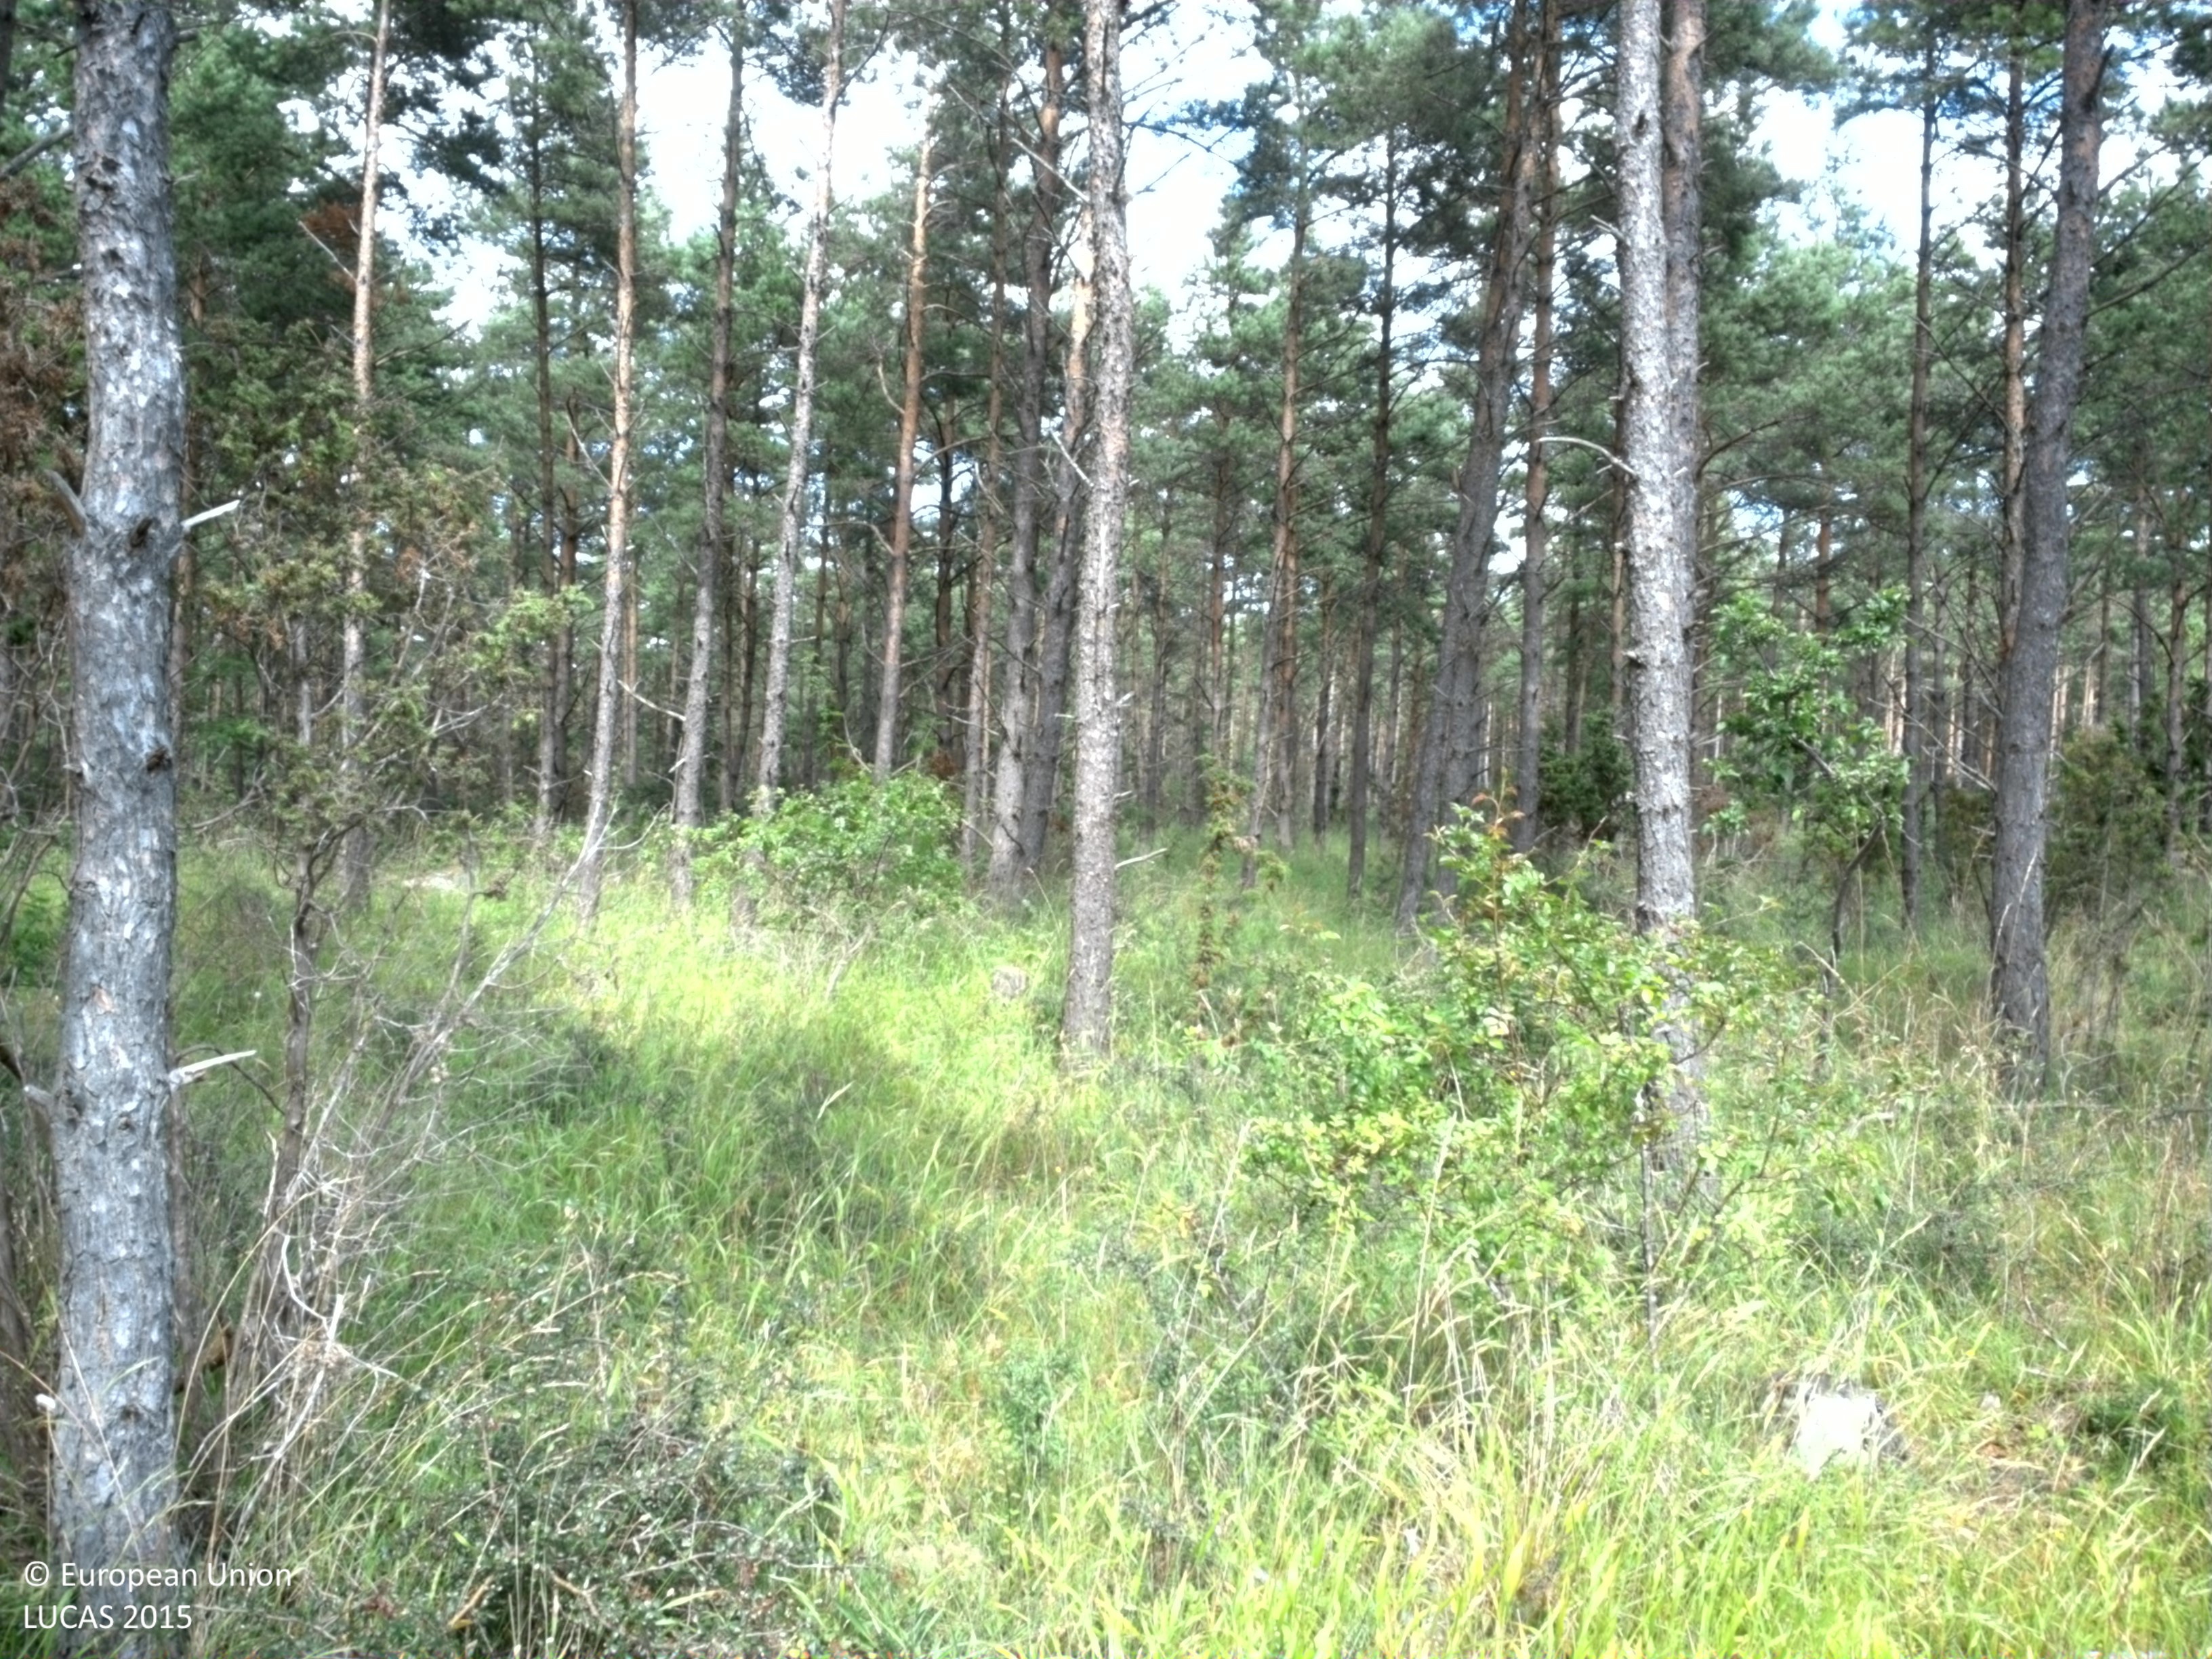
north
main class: Woodland
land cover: Pine dominated coniferous woodland
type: hemiboreal forest and nemoral coniferous forest and mixed broadleaved-coniferous forest
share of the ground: > 75 %
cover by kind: coniferous forest trees 75 %, herbaceous plants 15 %, shrubs 10 %
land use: Forestry
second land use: Agriculture (excluding fallow land and kitchen gardens)
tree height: > 5 m
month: July
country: SE
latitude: 57.1553
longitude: 18.1911
